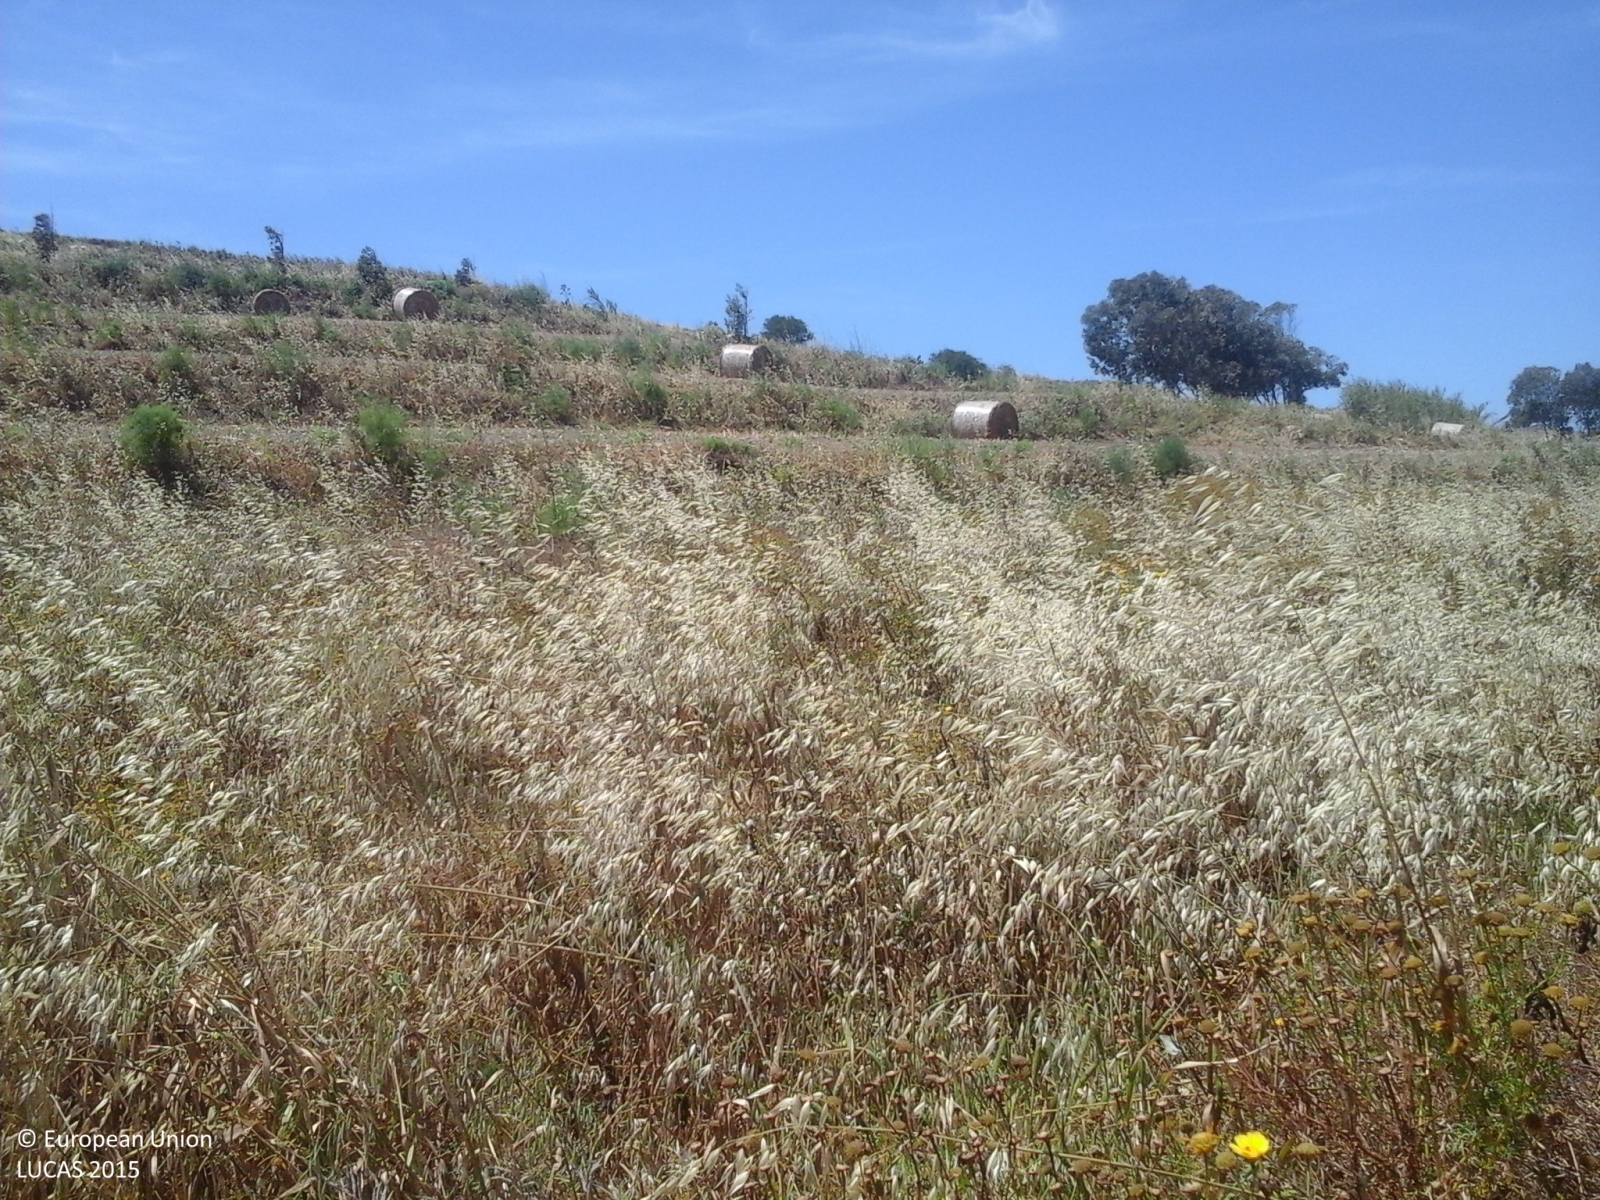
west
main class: Grassland
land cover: Spontaneously vegetated surfaces
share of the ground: > 75 %
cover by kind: herbaceous plants 100 %
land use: Agriculture (excluding fallow land and kitchen gardens)
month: May
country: MT
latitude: 36.0521
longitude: 14.2352
